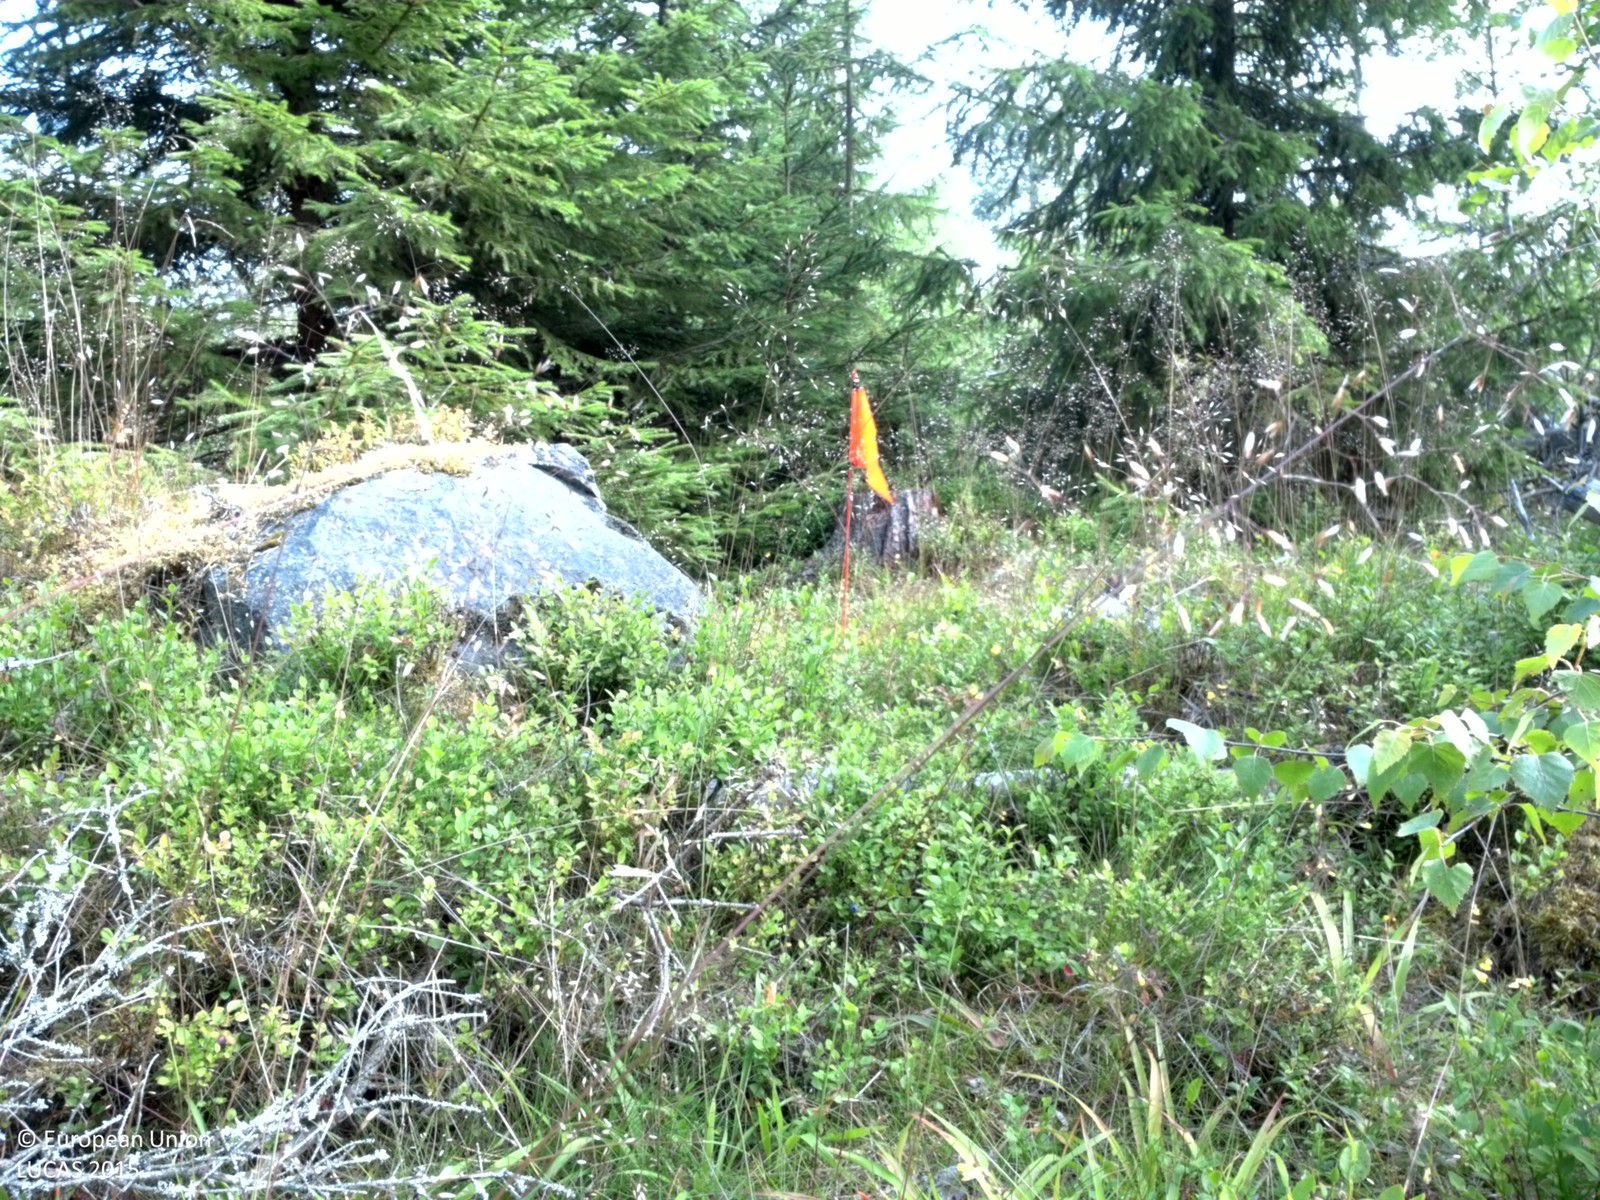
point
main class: Woodland
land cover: Spruce dominated mixed woodland
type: boreal forest
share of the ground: 50 - 75 %
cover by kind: coniferous forest trees 45 %, lichens and mosses 30 %, broadleaved forest trees 15 %, shrubs 10 %
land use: Forestry
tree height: > 5 m
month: July
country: SE
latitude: 60.0003
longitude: 18.7310
